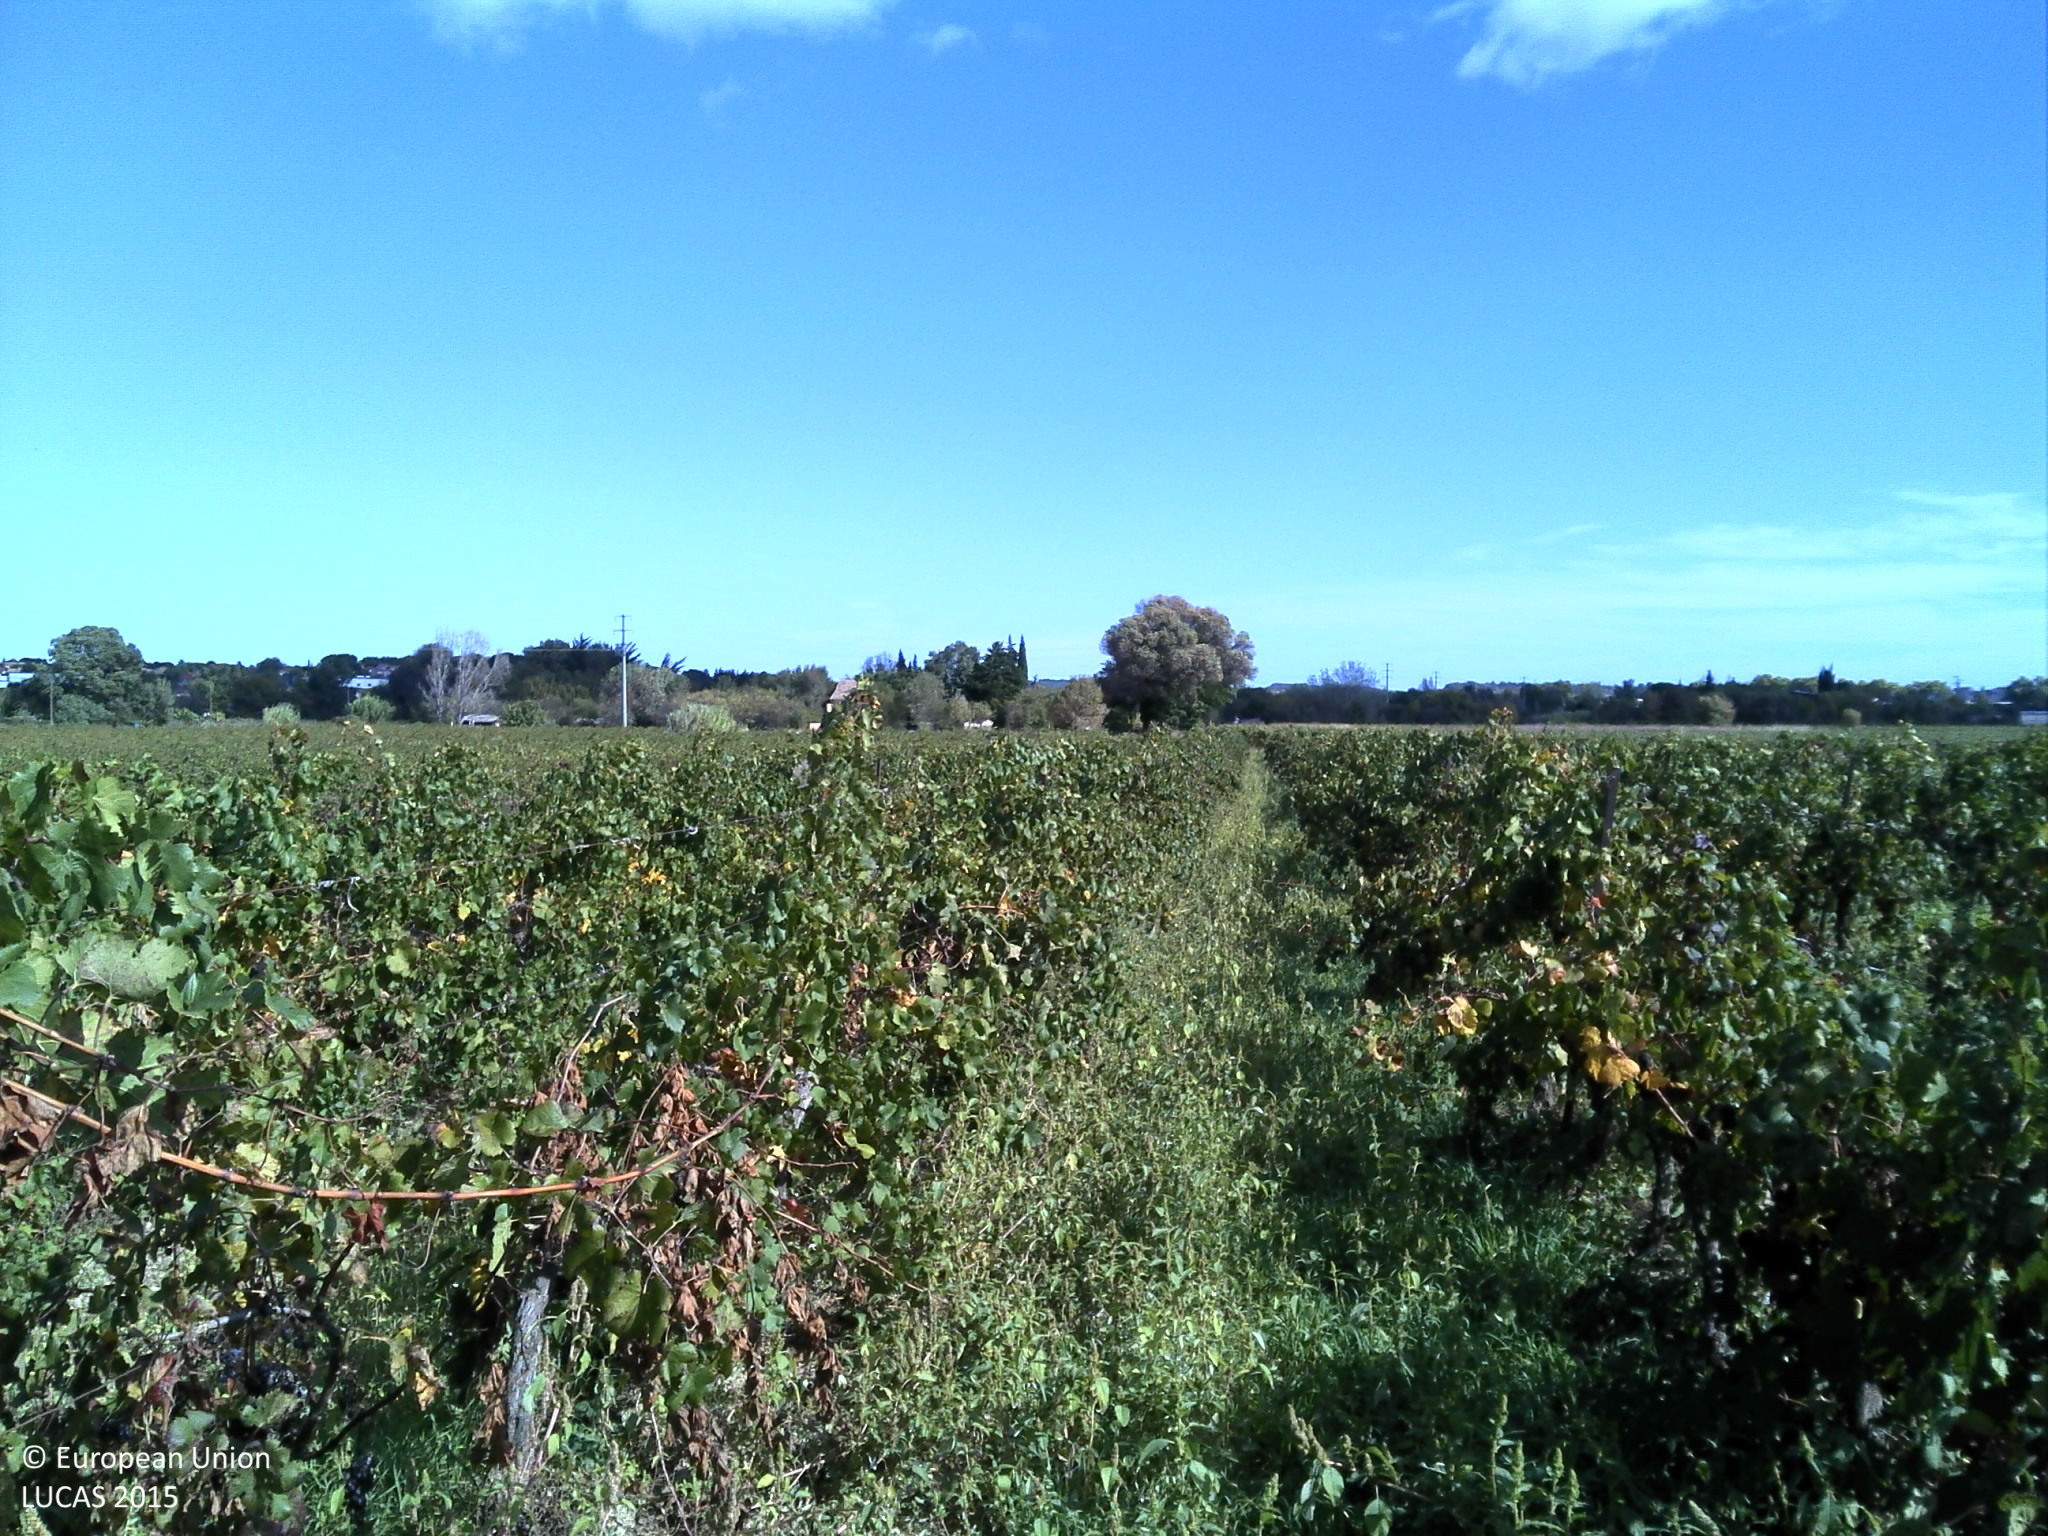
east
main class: Cropland
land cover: Vineyards
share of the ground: 10 - 25 %
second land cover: Spontaneously vegetated surfaces
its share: > 75 %
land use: Agriculture (excluding fallow land and kitchen gardens)
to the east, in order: Vineyards; Spontaneously vegetated surfaces; Grass margins; Ditches and canals; Grass margins; Vineyards; Grassland without tree/shrub cover; Vineyards; Grassland without tree/shrub cover; Broadleaved woodland
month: October
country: FR
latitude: 43.4526
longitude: 3.3978
